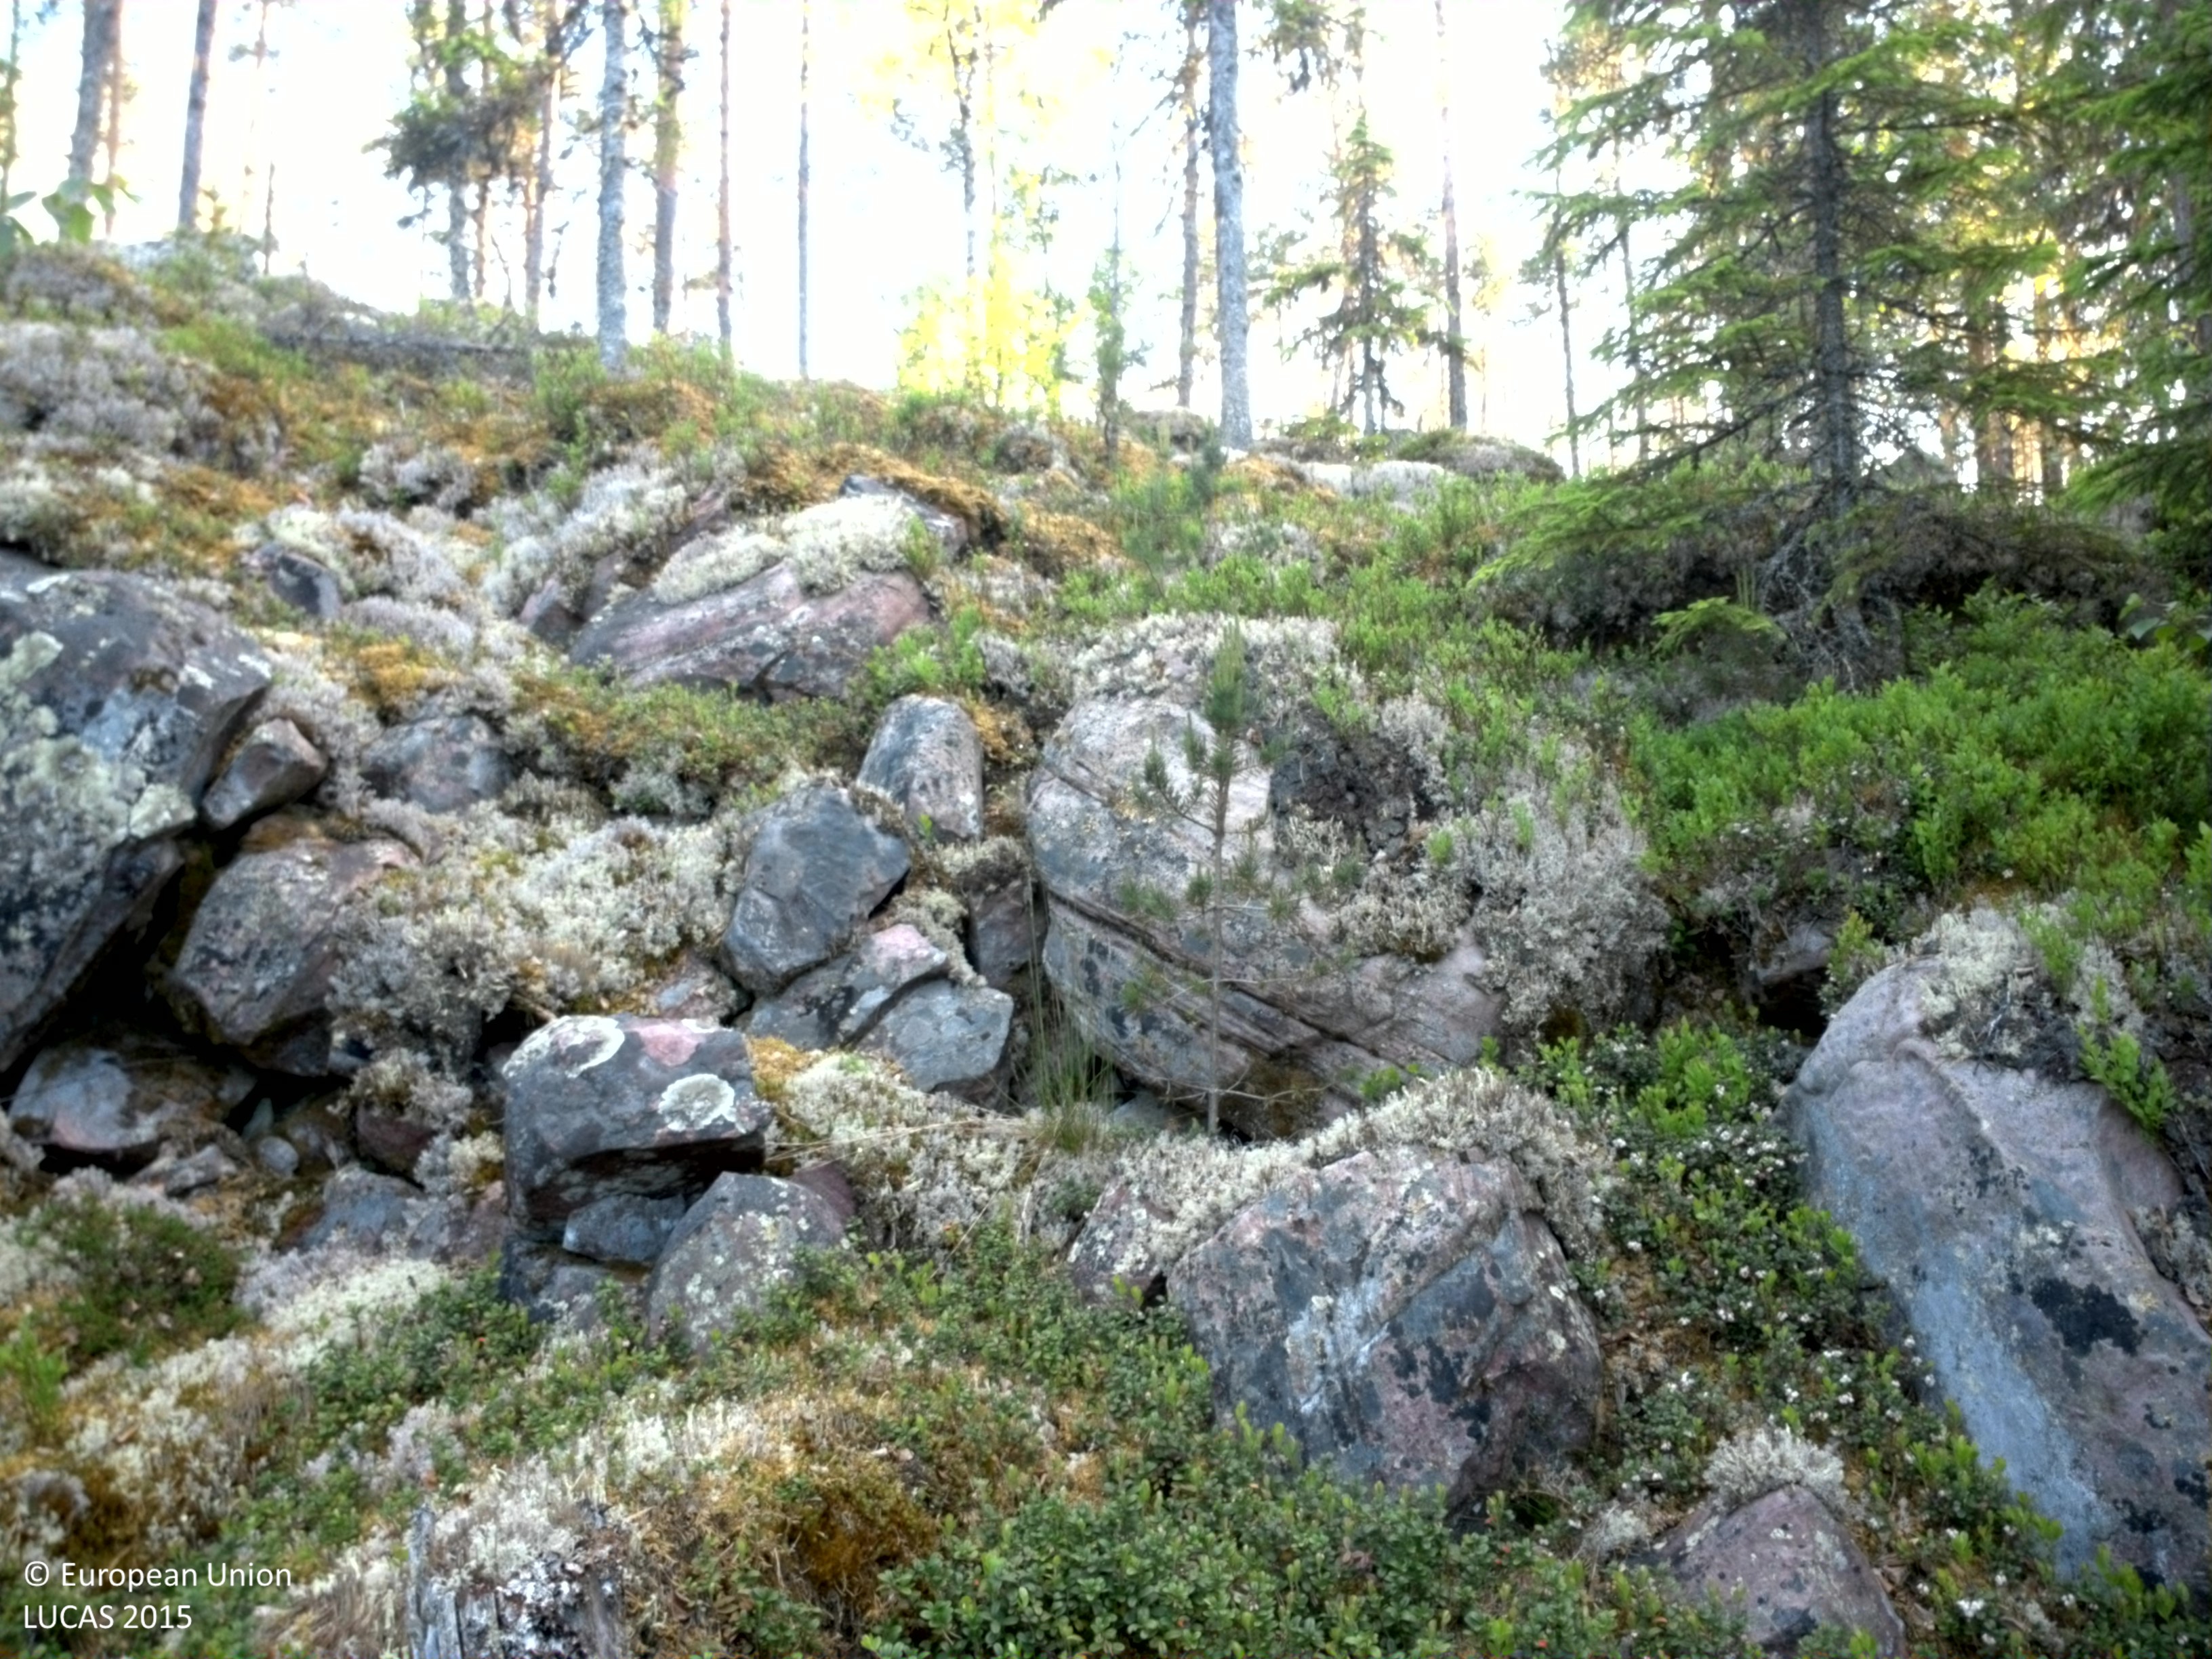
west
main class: Woodland
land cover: Other mixed woodland
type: boreal forest
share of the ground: 50 - 75 %
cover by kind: coniferous forest trees 30 %, shrubs 25 %, lichens and mosses 25 %, broadleaved forest trees 10 %, herbaceous plants 10 %
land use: Forestry
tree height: > 5 m
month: June
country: SE
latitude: 61.0891
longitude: 13.6409
